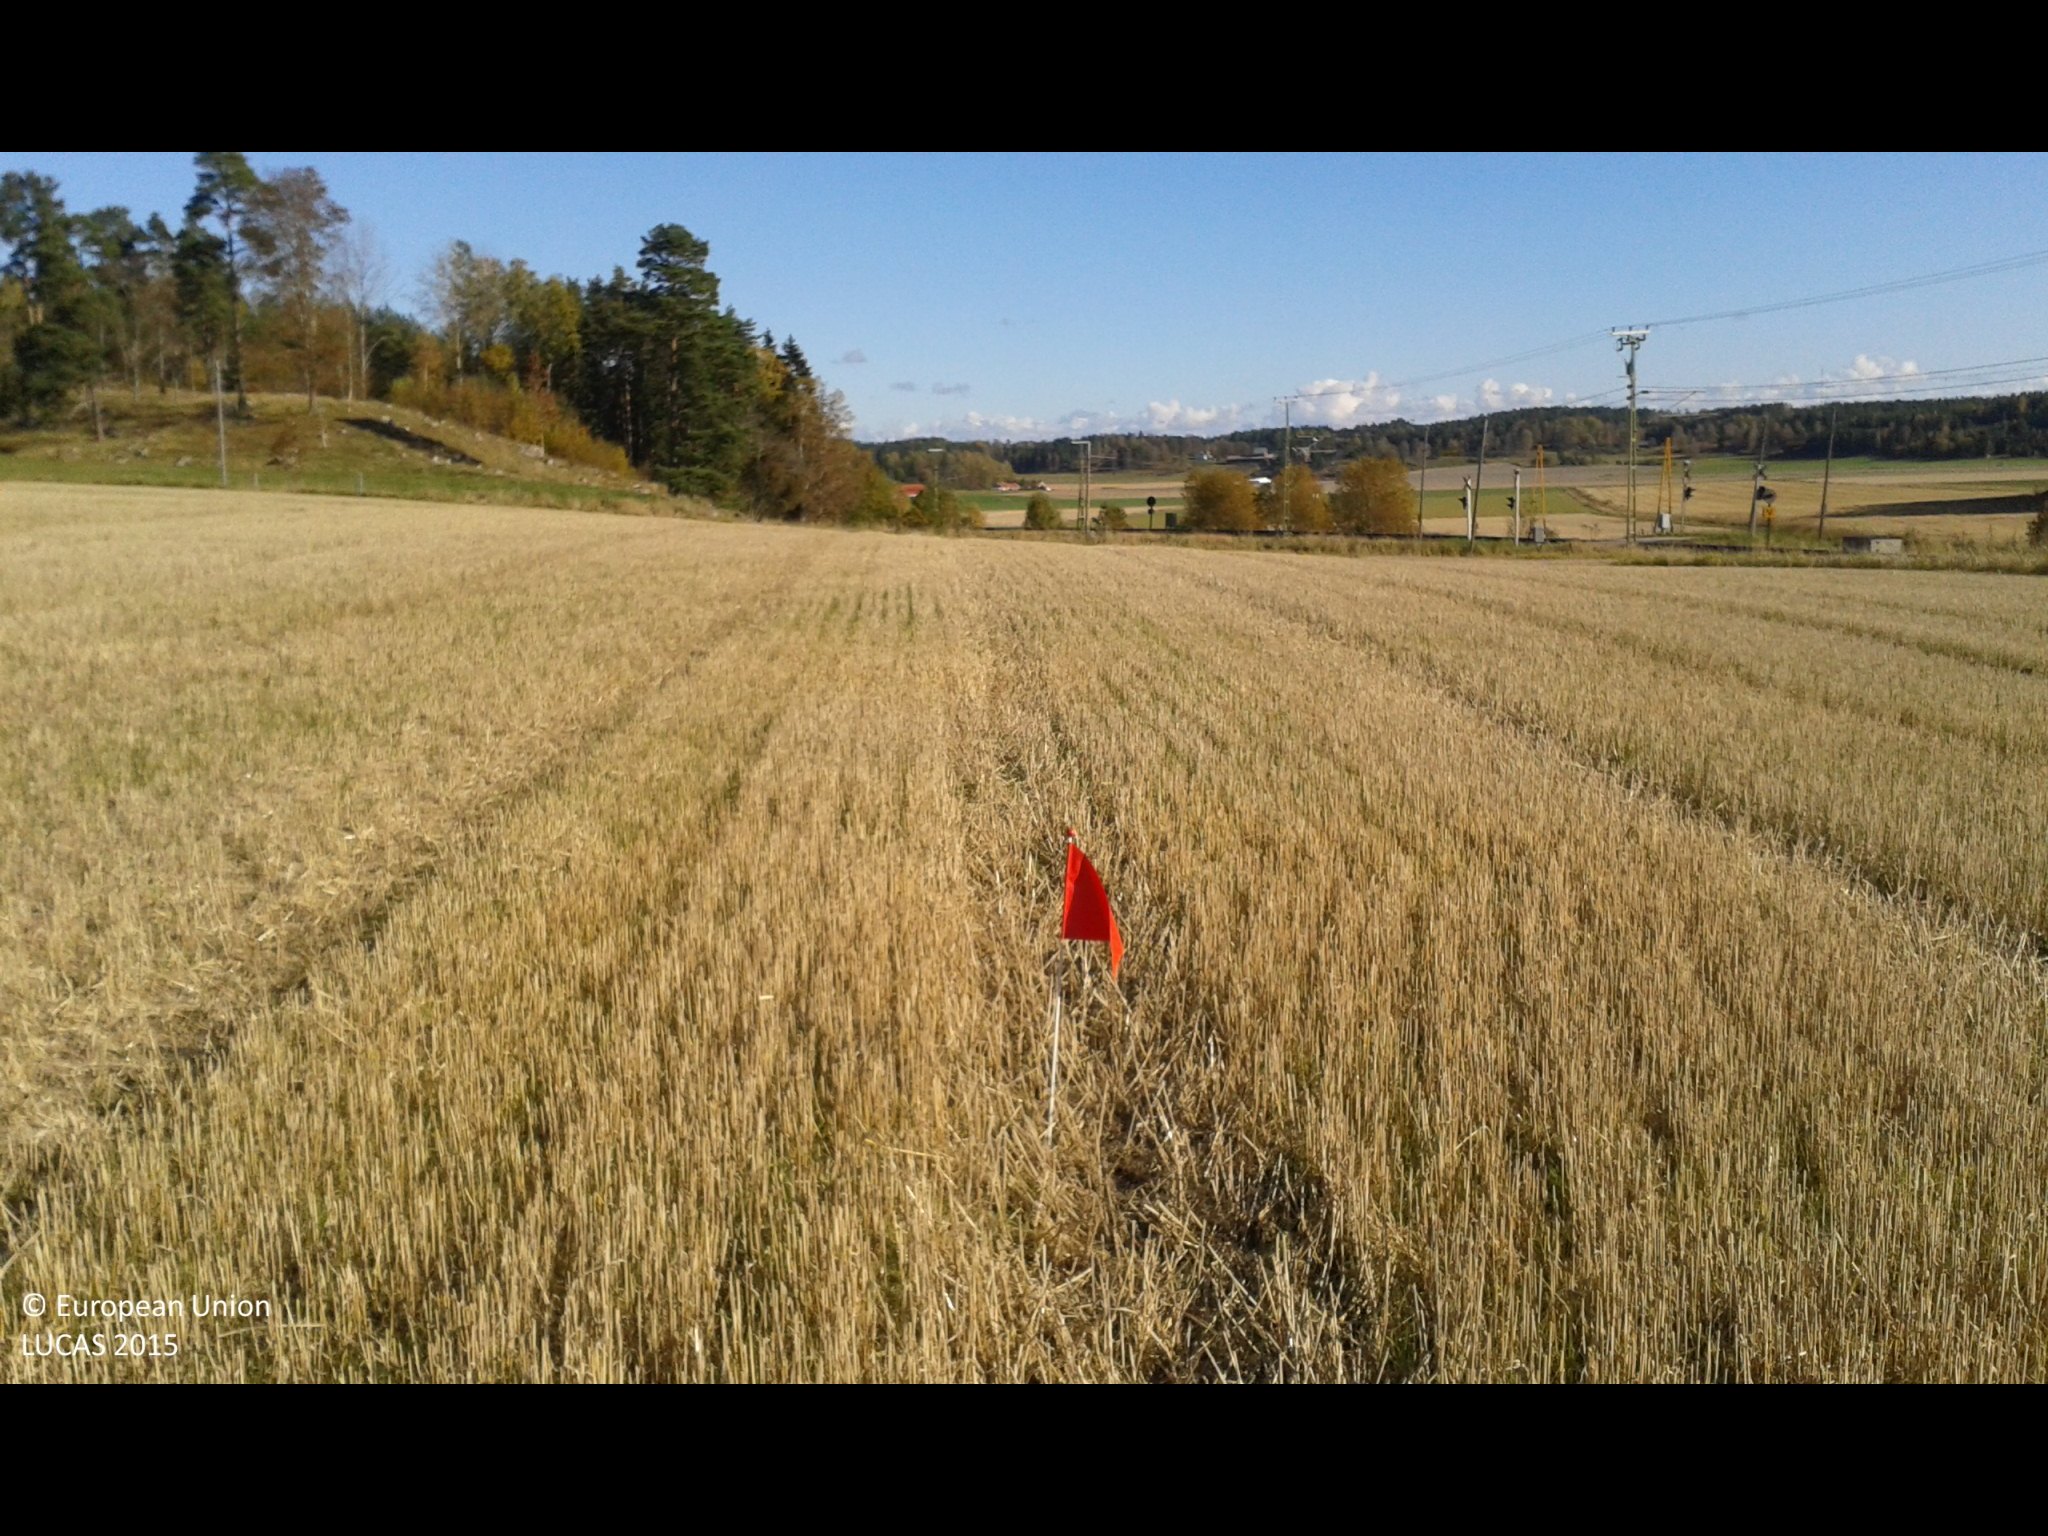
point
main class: Cropland
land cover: Barley
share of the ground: < 10 %
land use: Agriculture (excluding fallow land and kitchen gardens)
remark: Harvested field
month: October
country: SE
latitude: 58.8545
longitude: 17.2603
